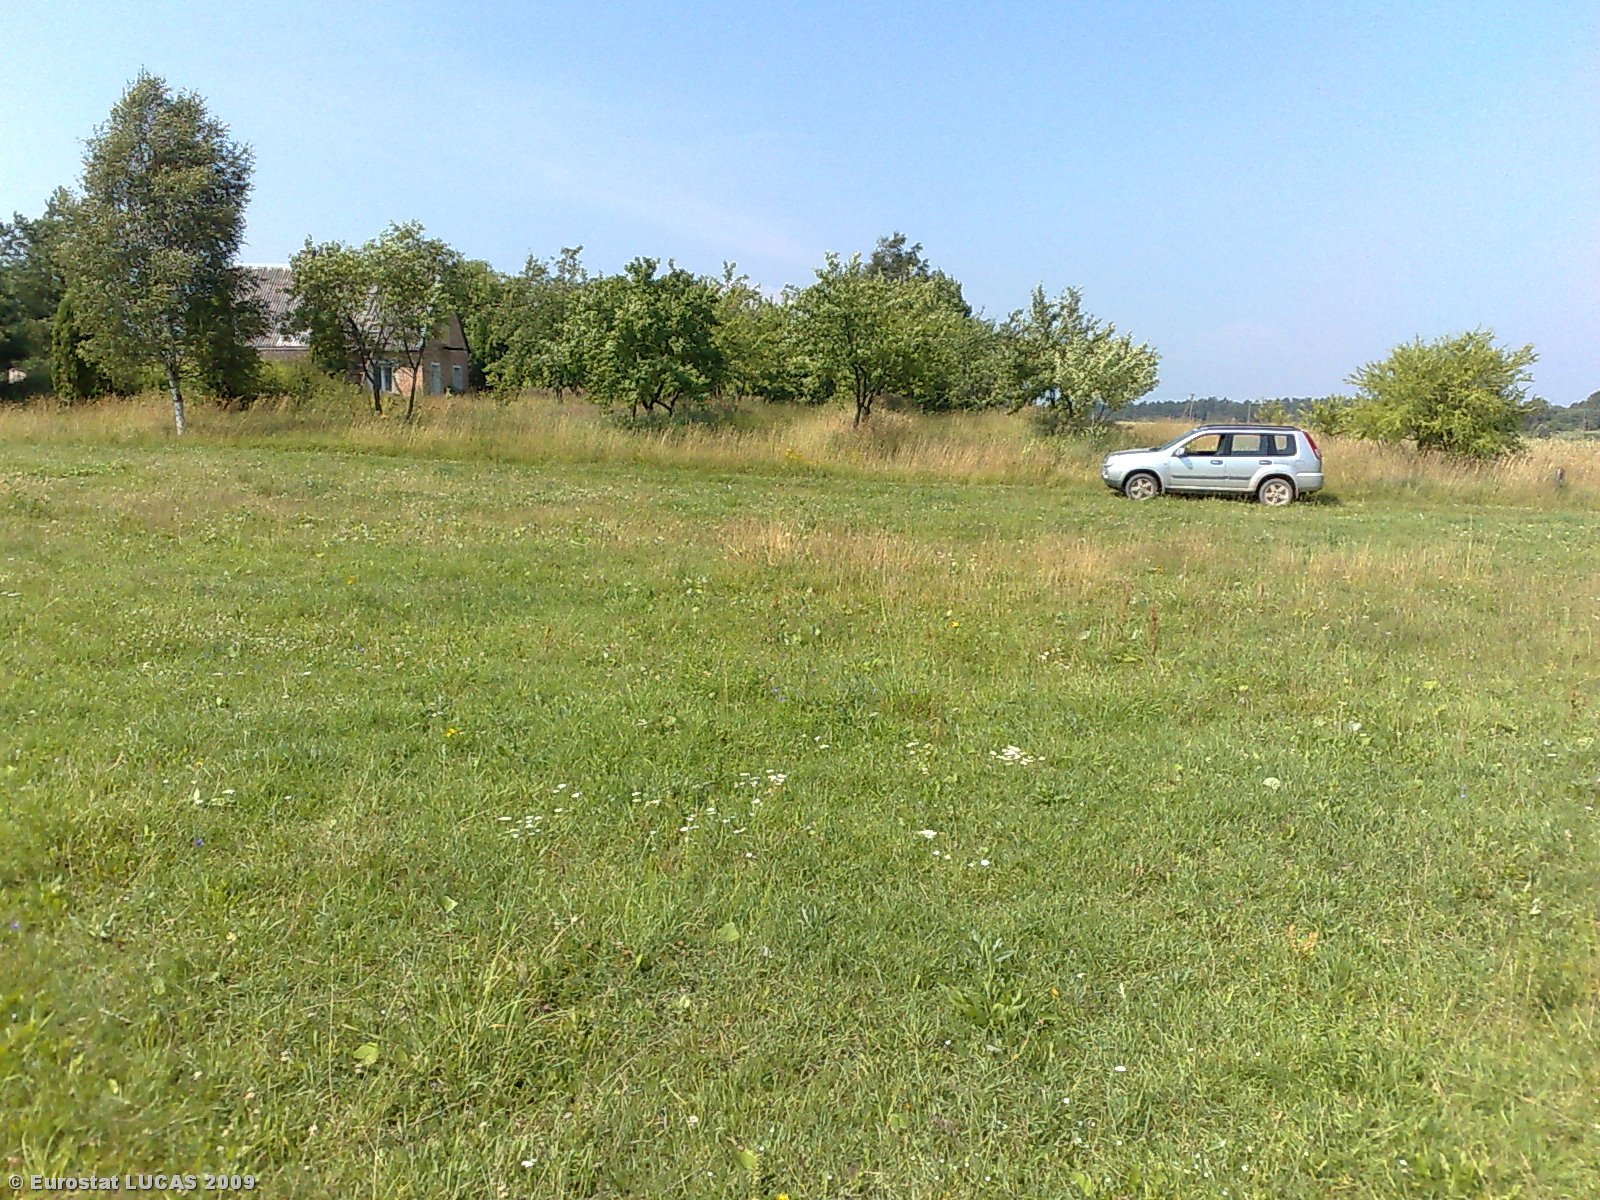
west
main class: Grassland
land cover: Grassland without tree/shrub cover
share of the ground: > 75 %
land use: Agriculture (excluding fallow land and kitchen gardens)
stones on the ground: < 10 %
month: July
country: LT
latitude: 55.9242
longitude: 22.8196
